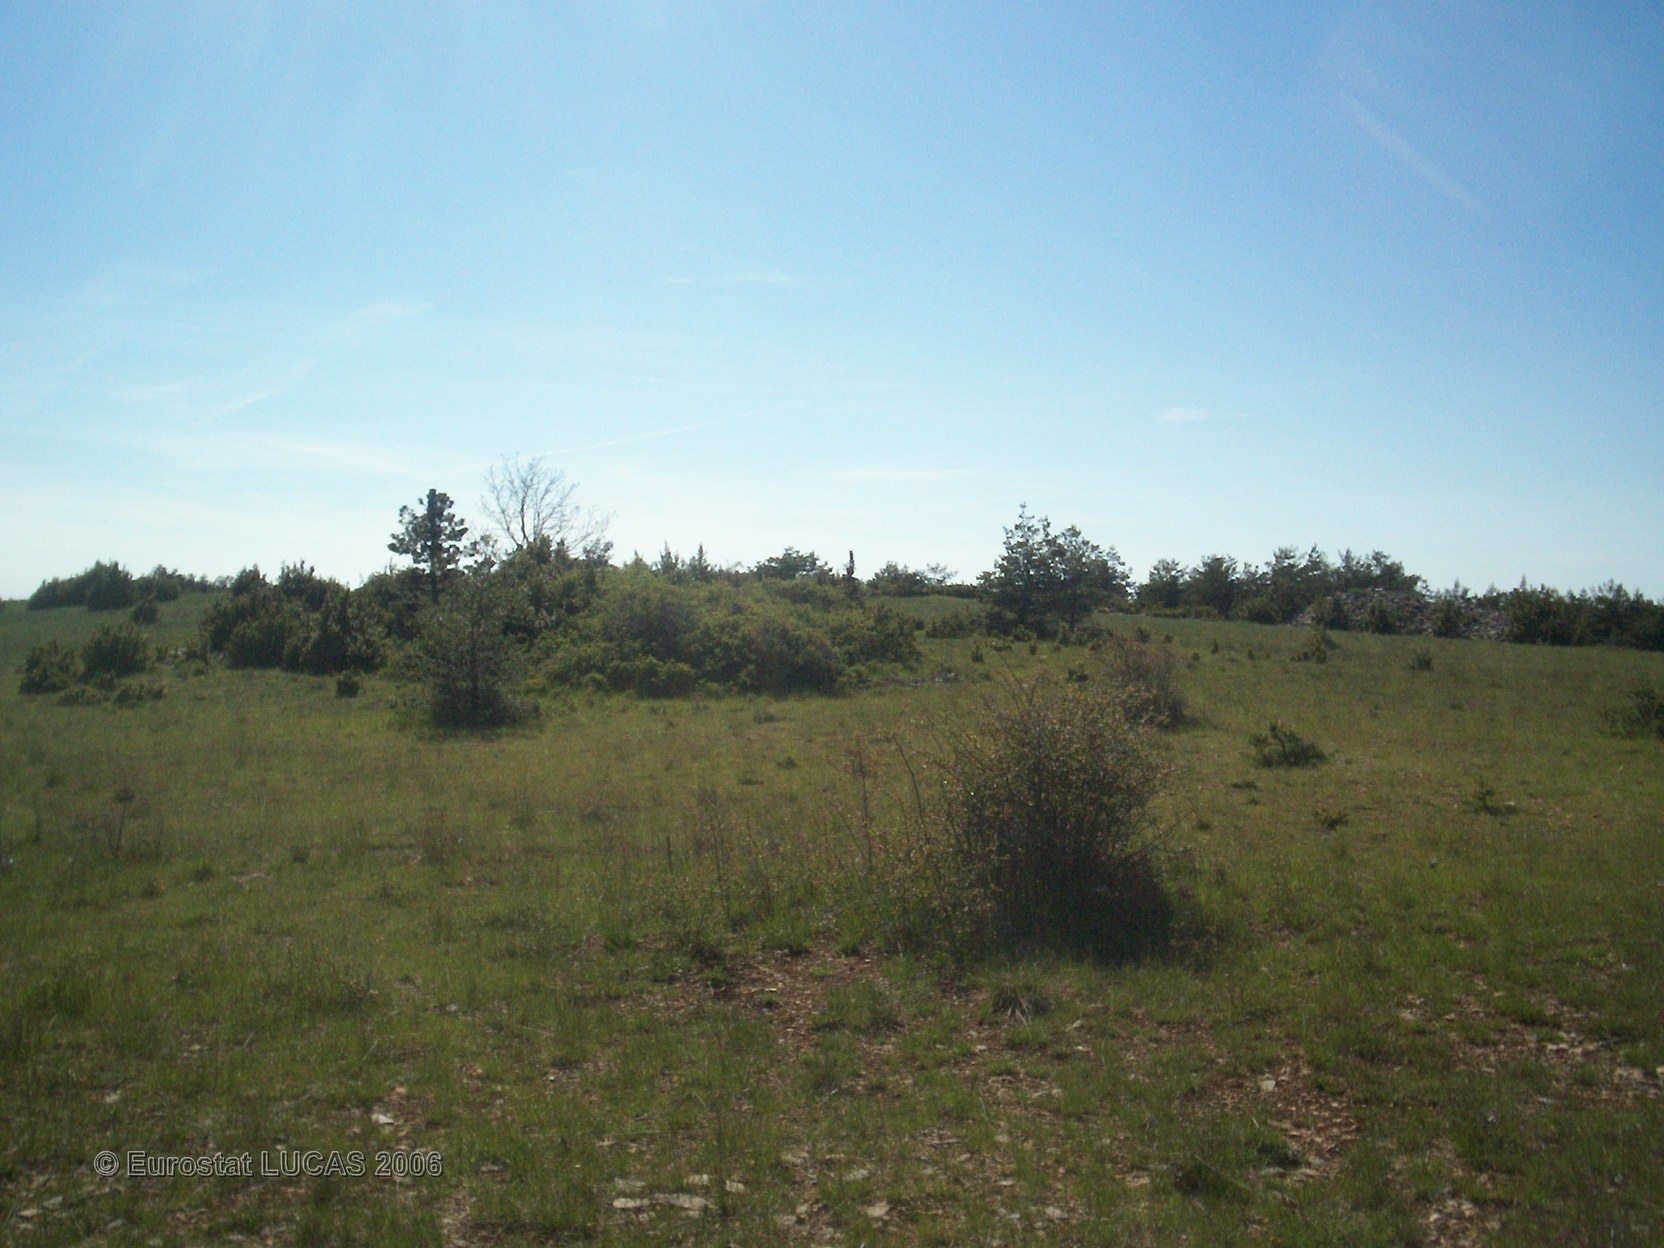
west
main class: Grassland
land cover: Grassland without tree/shrub cover
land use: Agriculture (excluding fallow land and kitchen gardens)
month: May
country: FR
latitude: 44.1384
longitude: 3.3689
